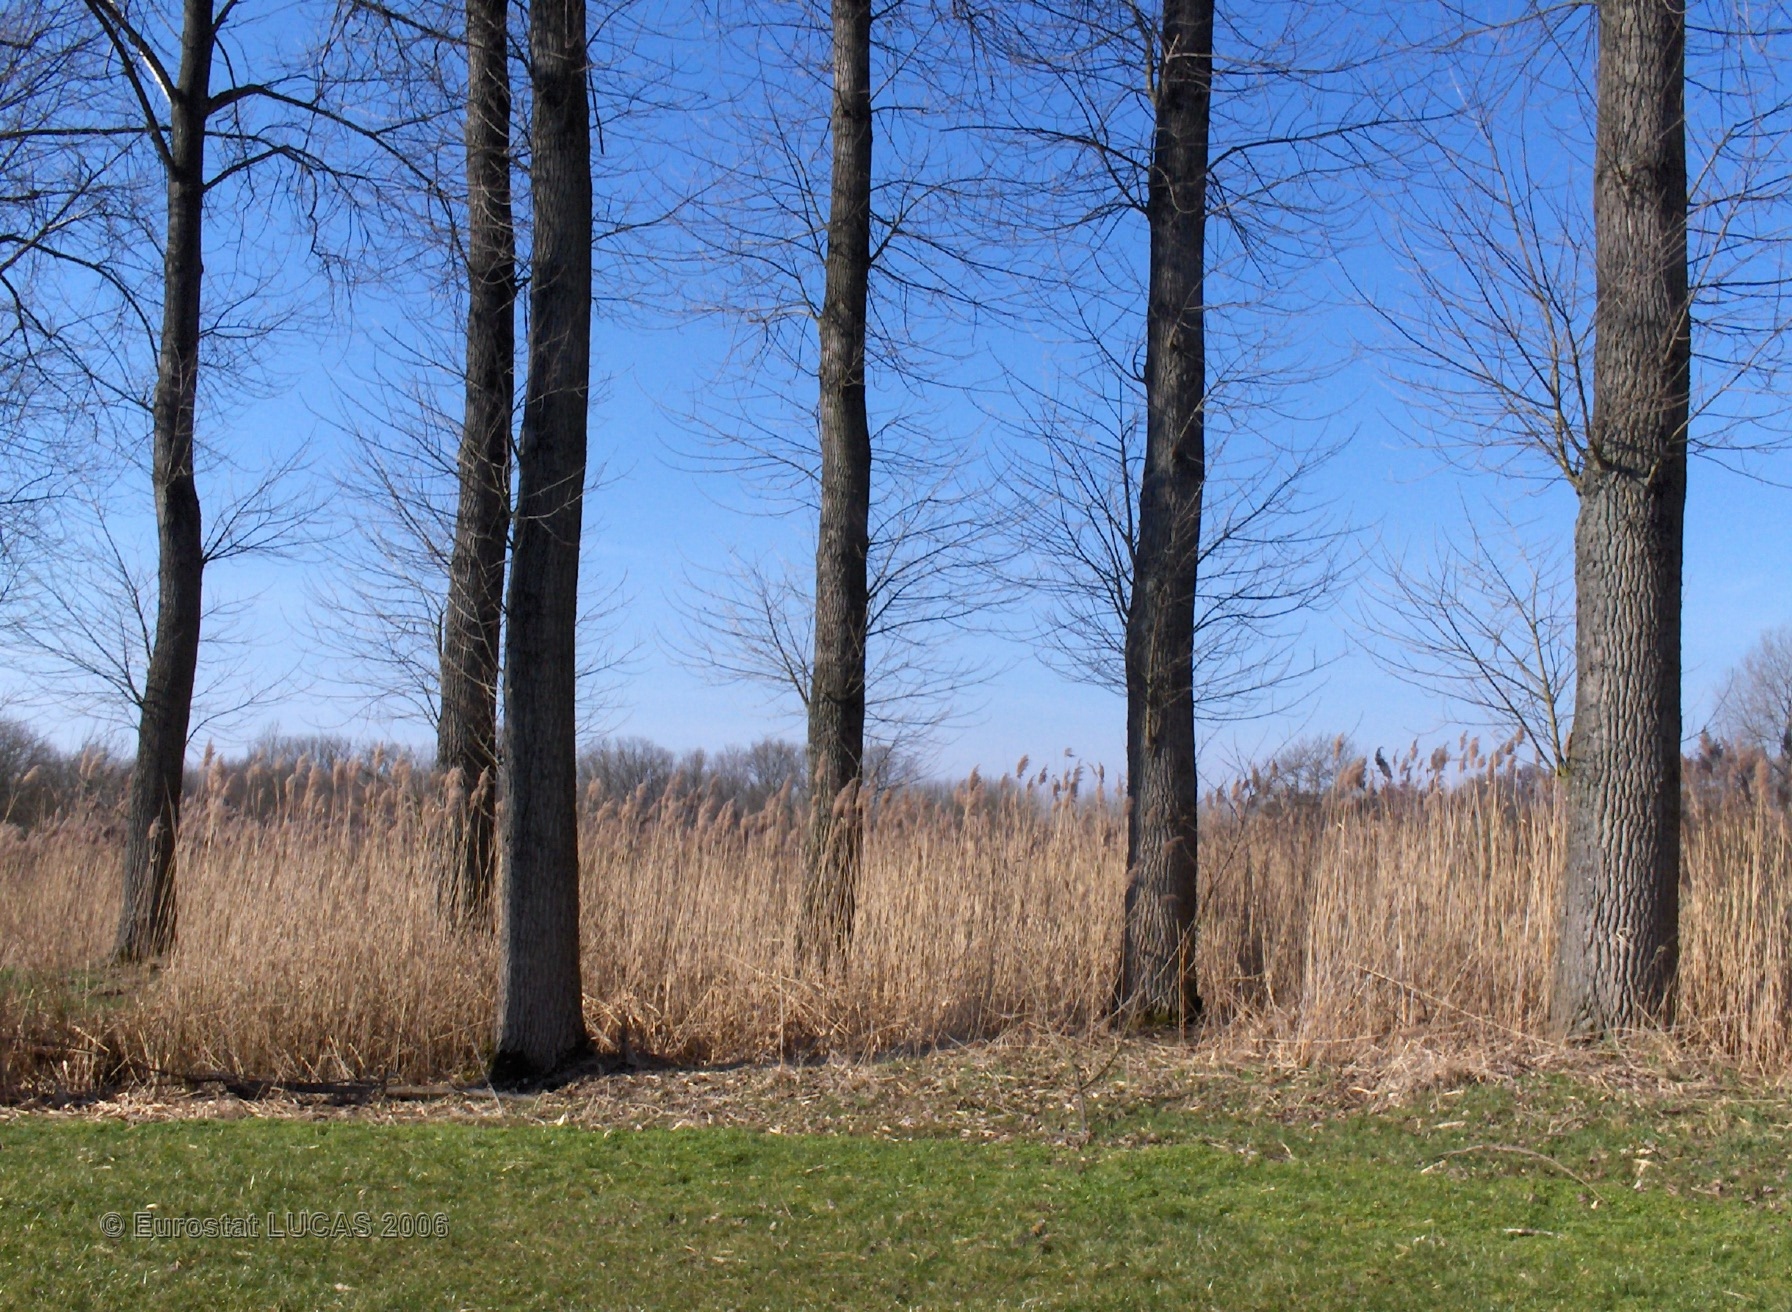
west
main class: Grassland
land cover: Grassland without tree/shrub cover
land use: Agriculture (excluding fallow land and kitchen gardens)
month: March
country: BE
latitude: 50.9669
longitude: 5.2273
